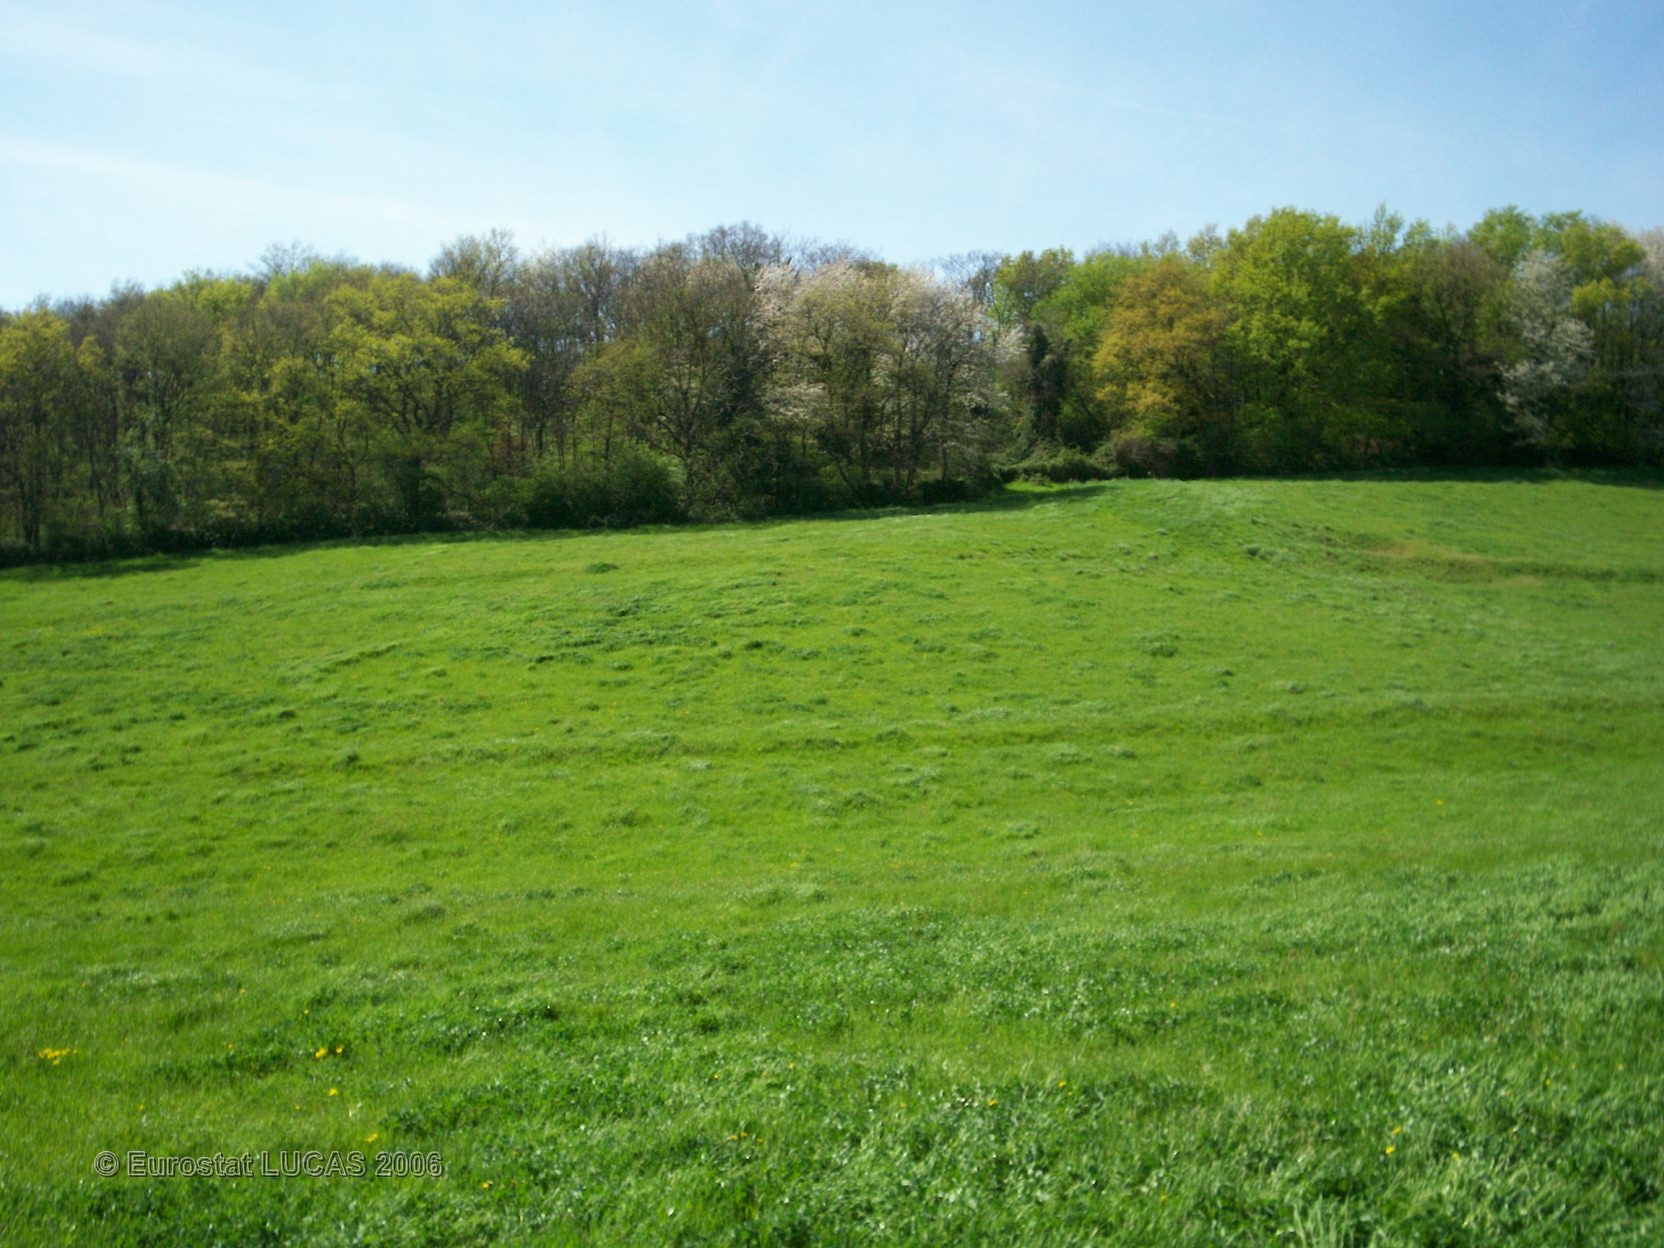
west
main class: Grassland
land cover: Grassland without tree/shrub cover
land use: Agriculture (excluding fallow land and kitchen gardens)
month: April
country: FR
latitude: 45.5936
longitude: 4.8123
